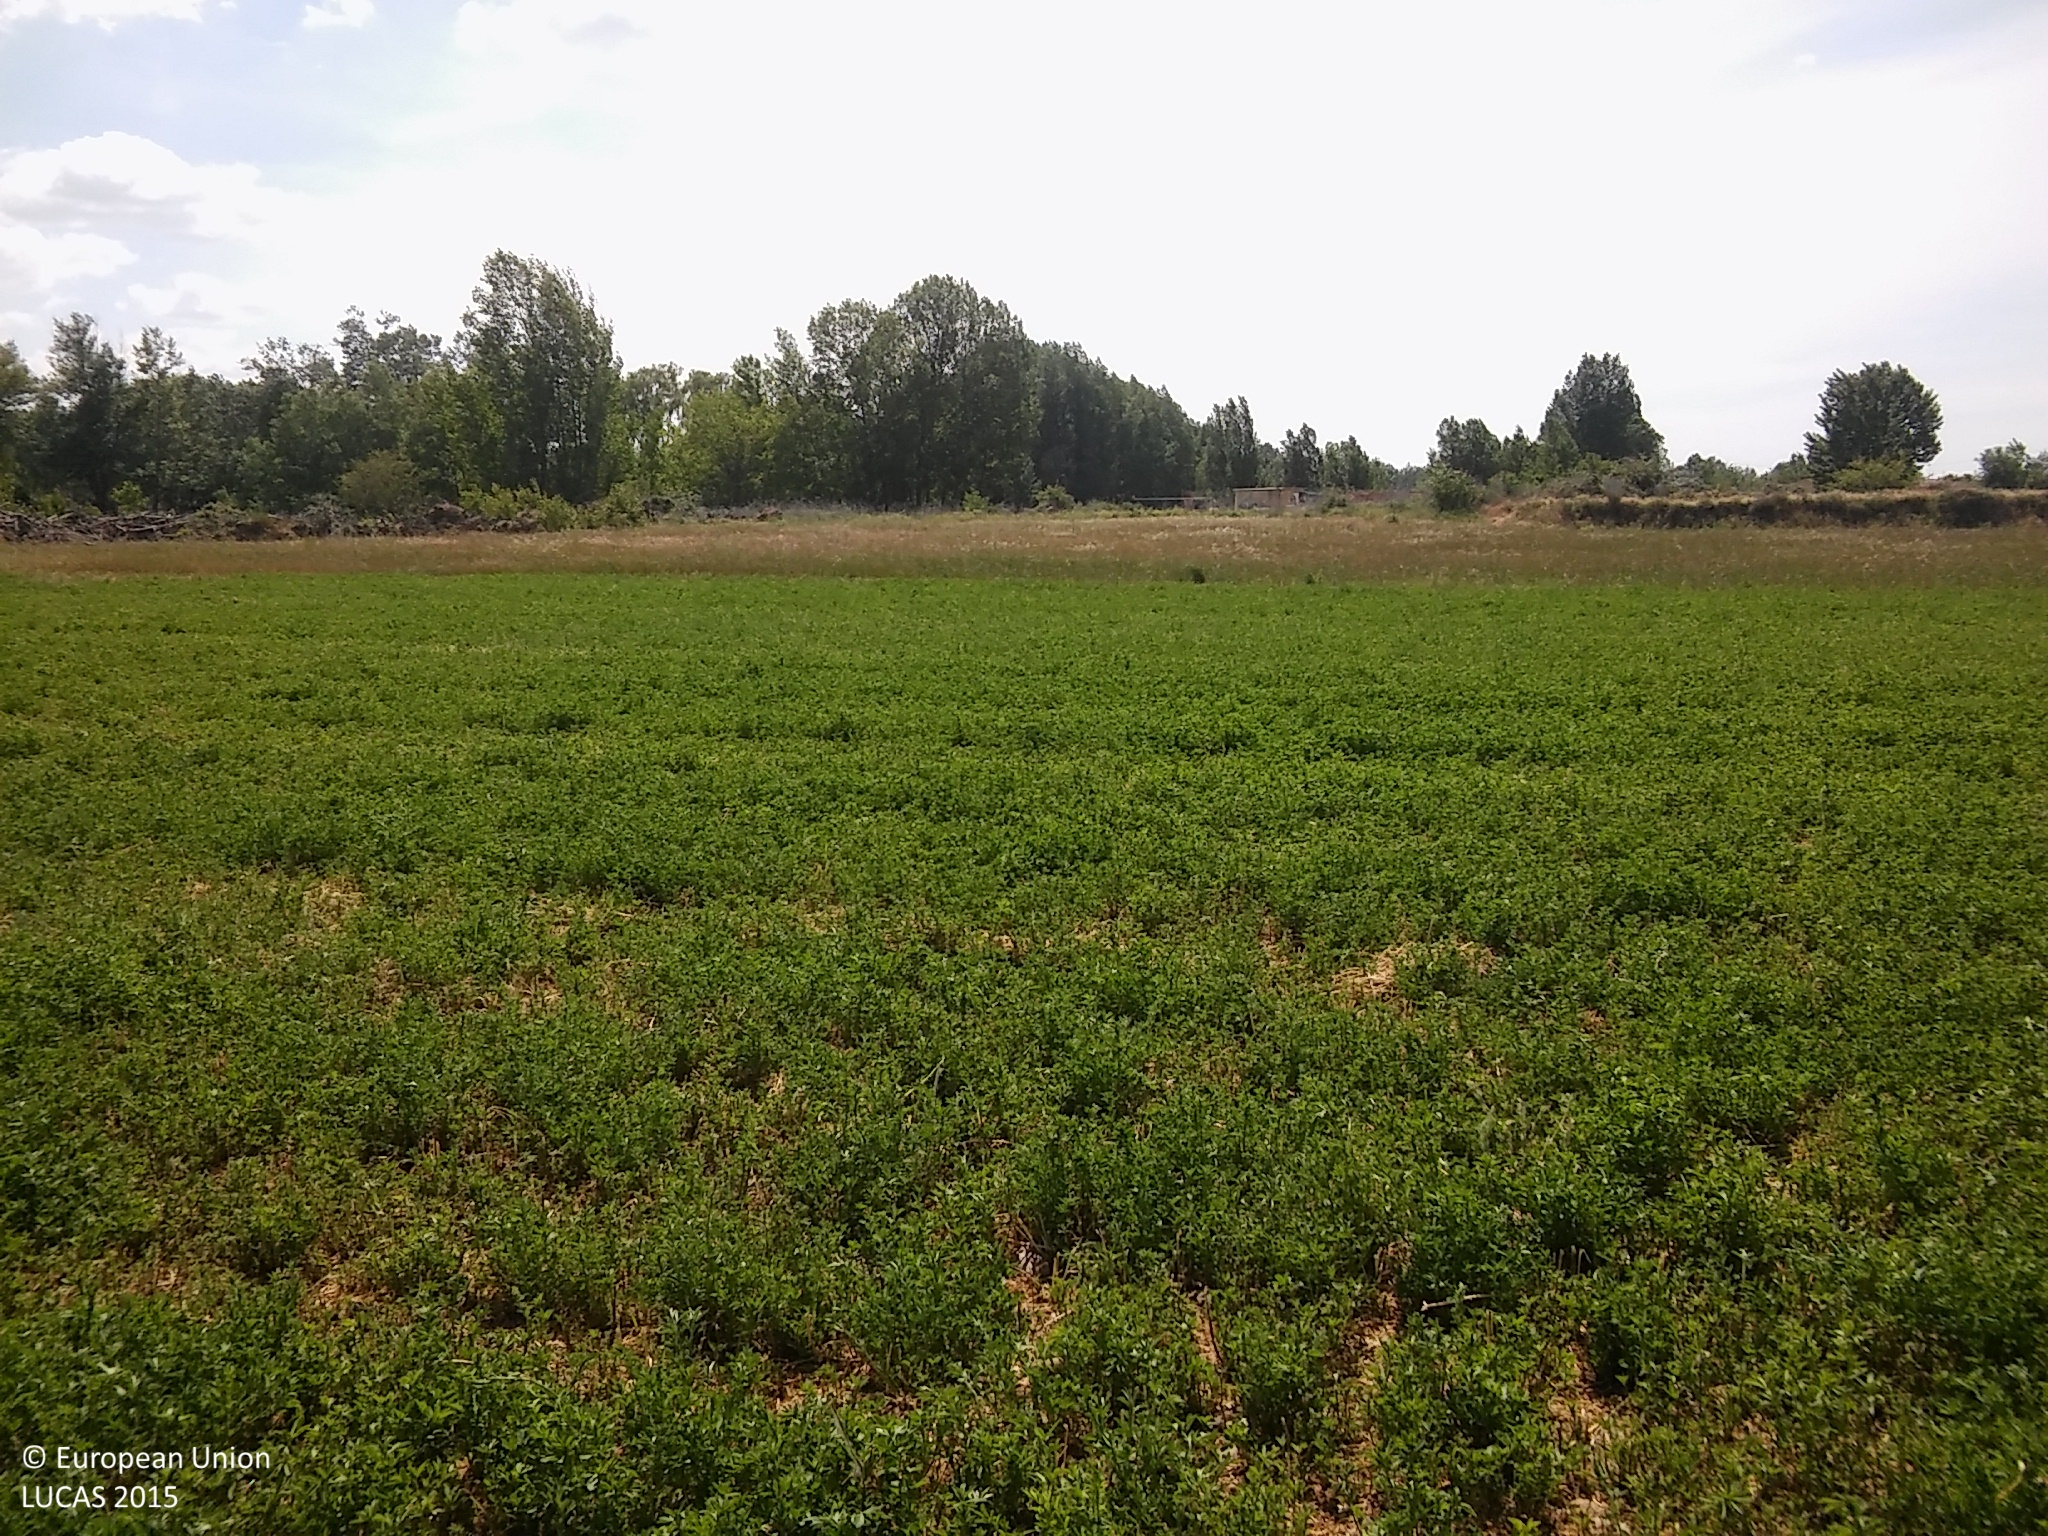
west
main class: Cropland
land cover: Lucerne
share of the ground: 25 - 50 %
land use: Agriculture (excluding fallow land and kitchen gardens)
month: May
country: ES
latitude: 41.6510
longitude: -3.6565
